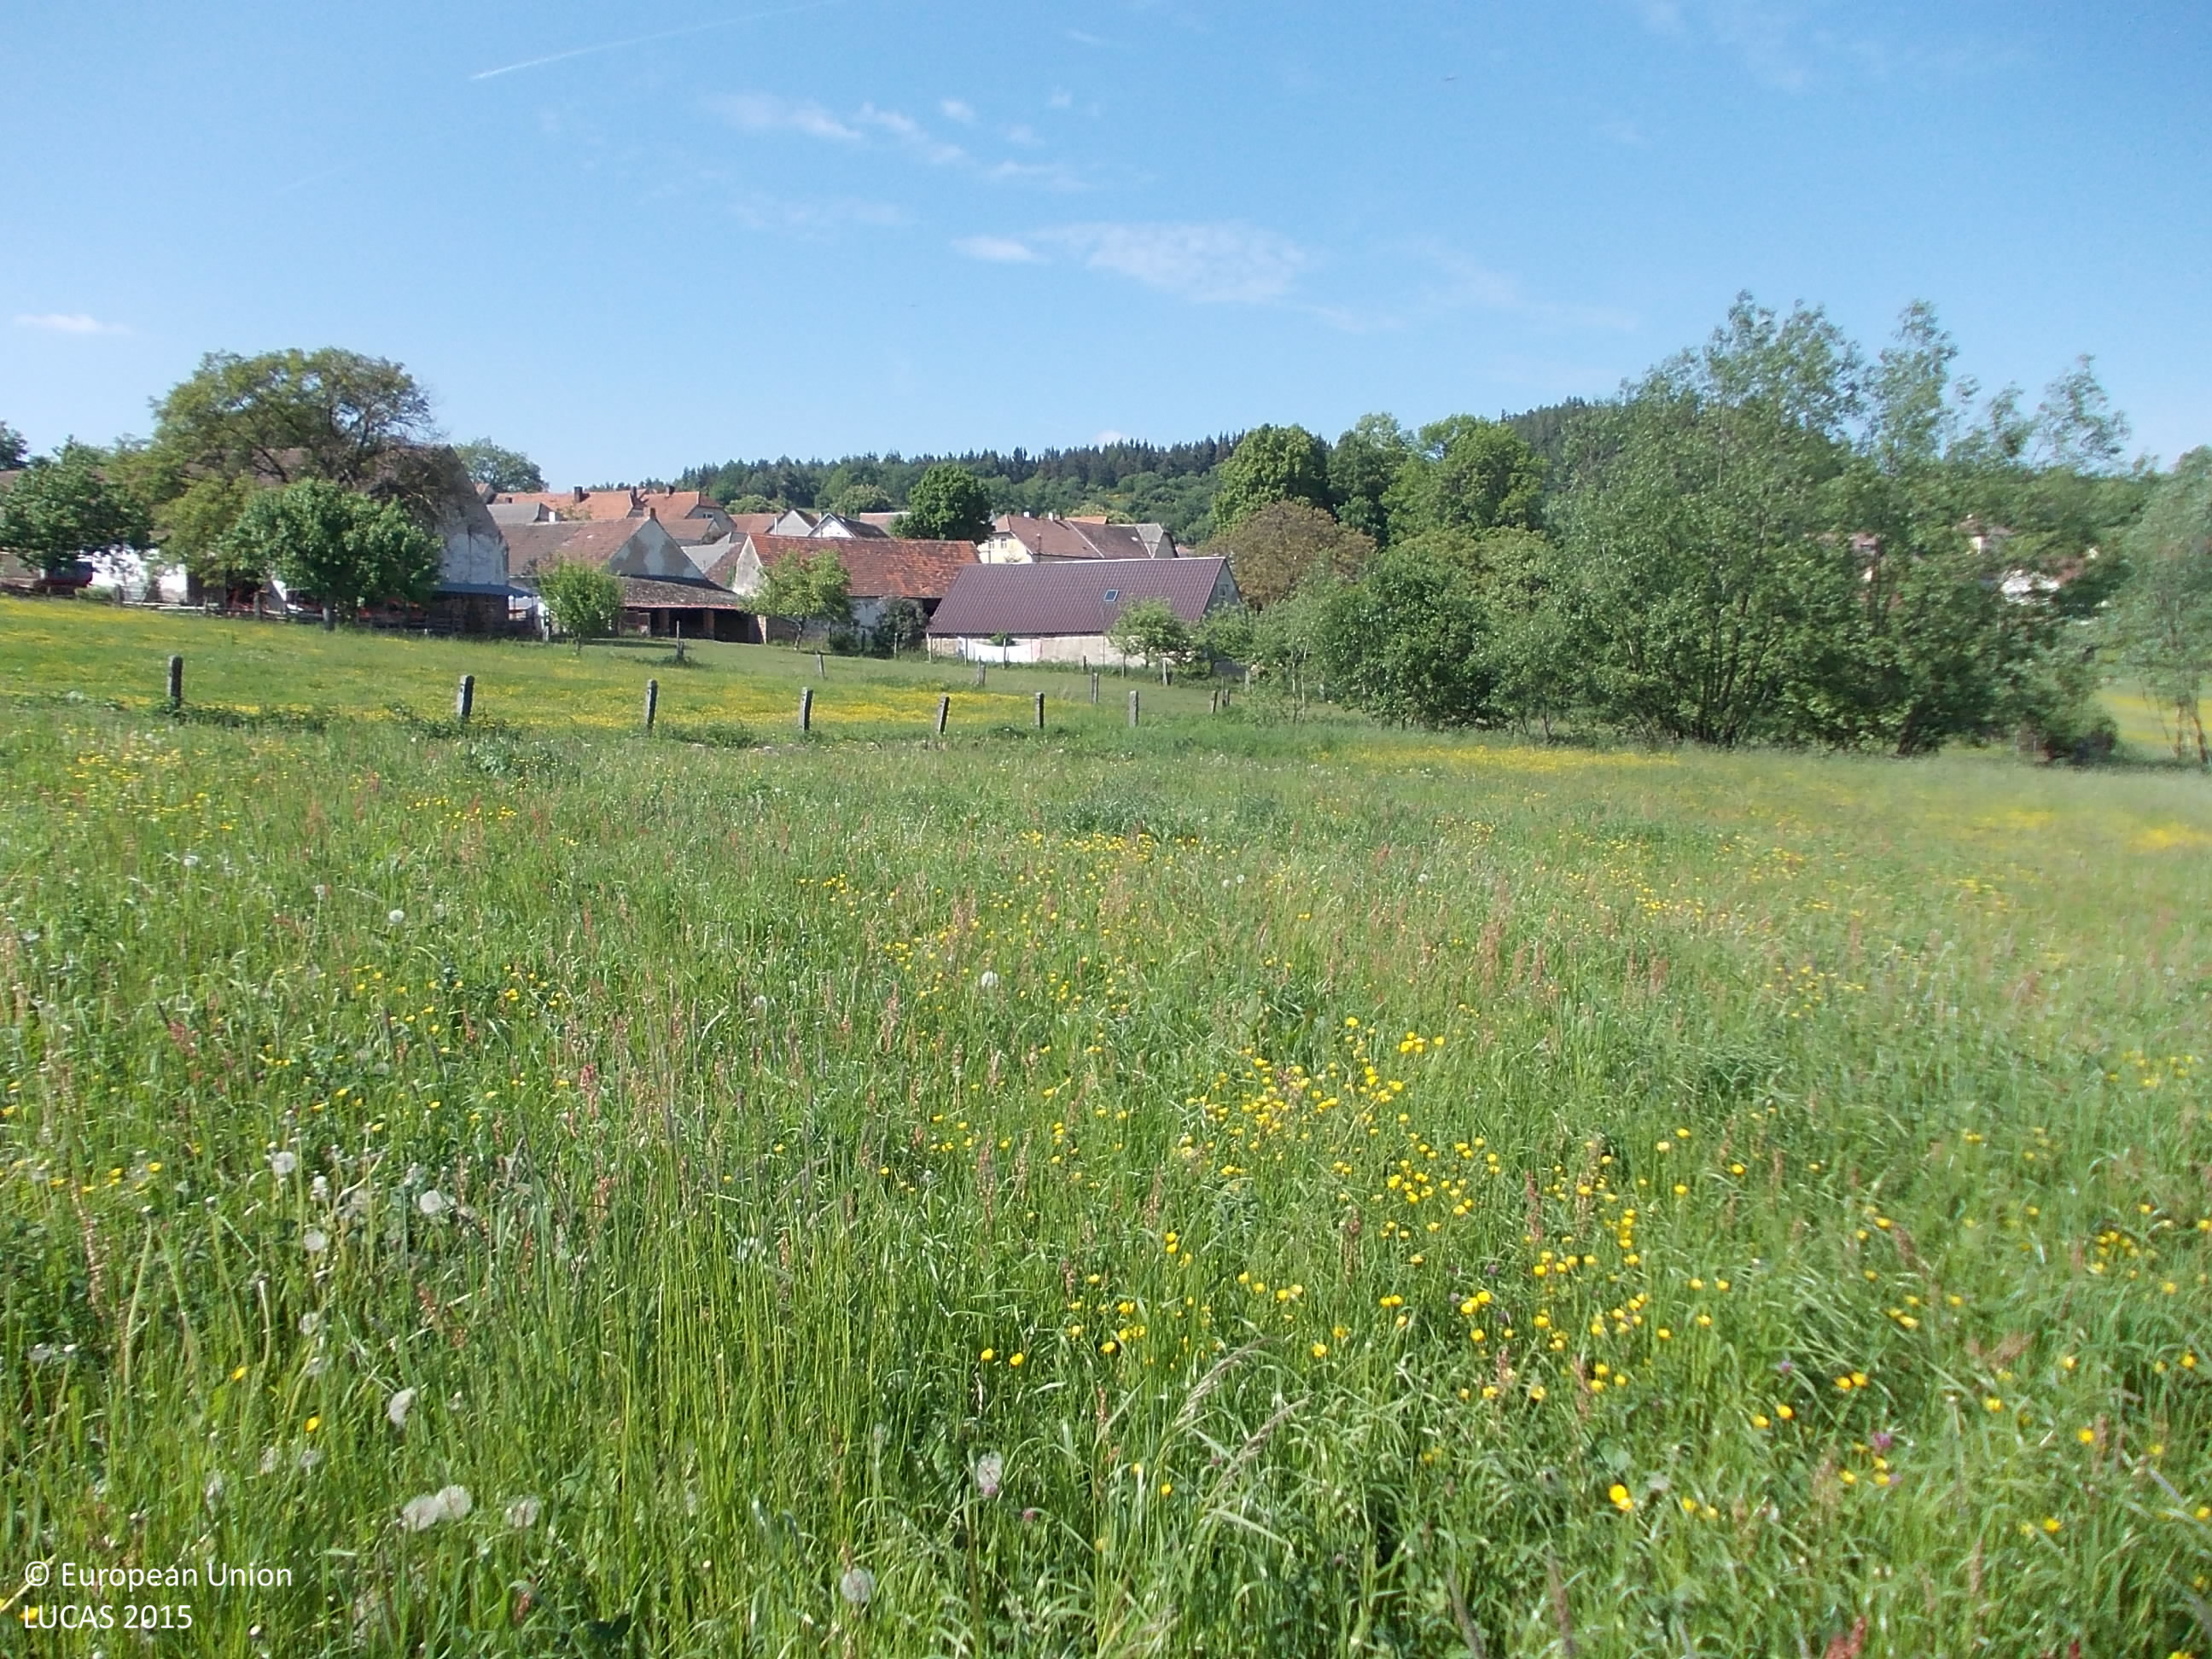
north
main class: Grassland
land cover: Grassland without tree/shrub cover
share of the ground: > 75 %
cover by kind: herbaceous plants 100 %
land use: Agriculture (excluding fallow land and kitchen gardens)
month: May
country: CZ
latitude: 49.2036
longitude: 13.7747
